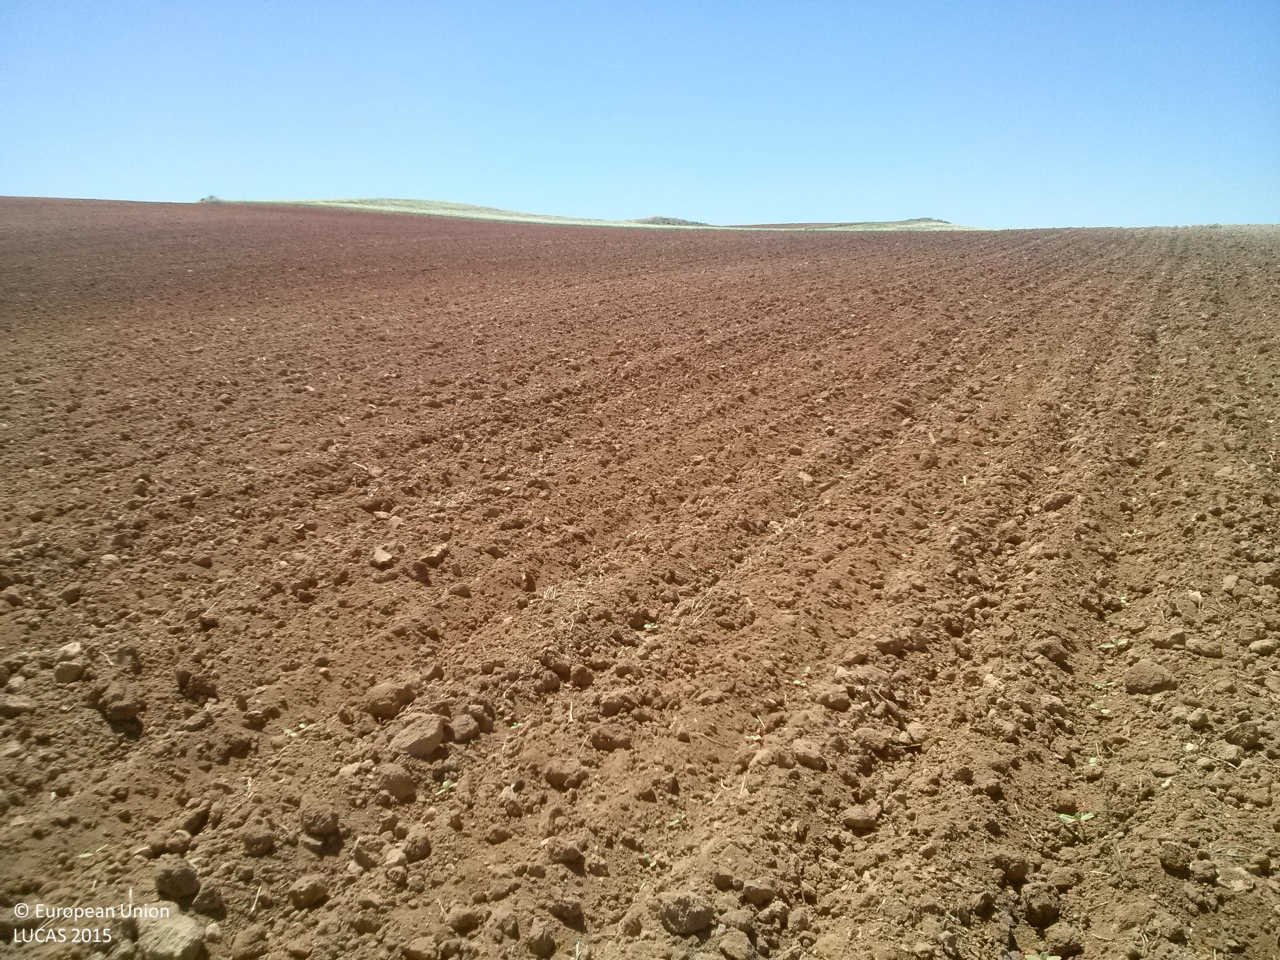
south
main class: Cropland
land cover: Sunflower
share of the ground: < 10 %
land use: Agriculture (excluding fallow land and kitchen gardens)
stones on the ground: < 10 %
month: May
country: ES
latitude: 40.2361
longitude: -2.7533
